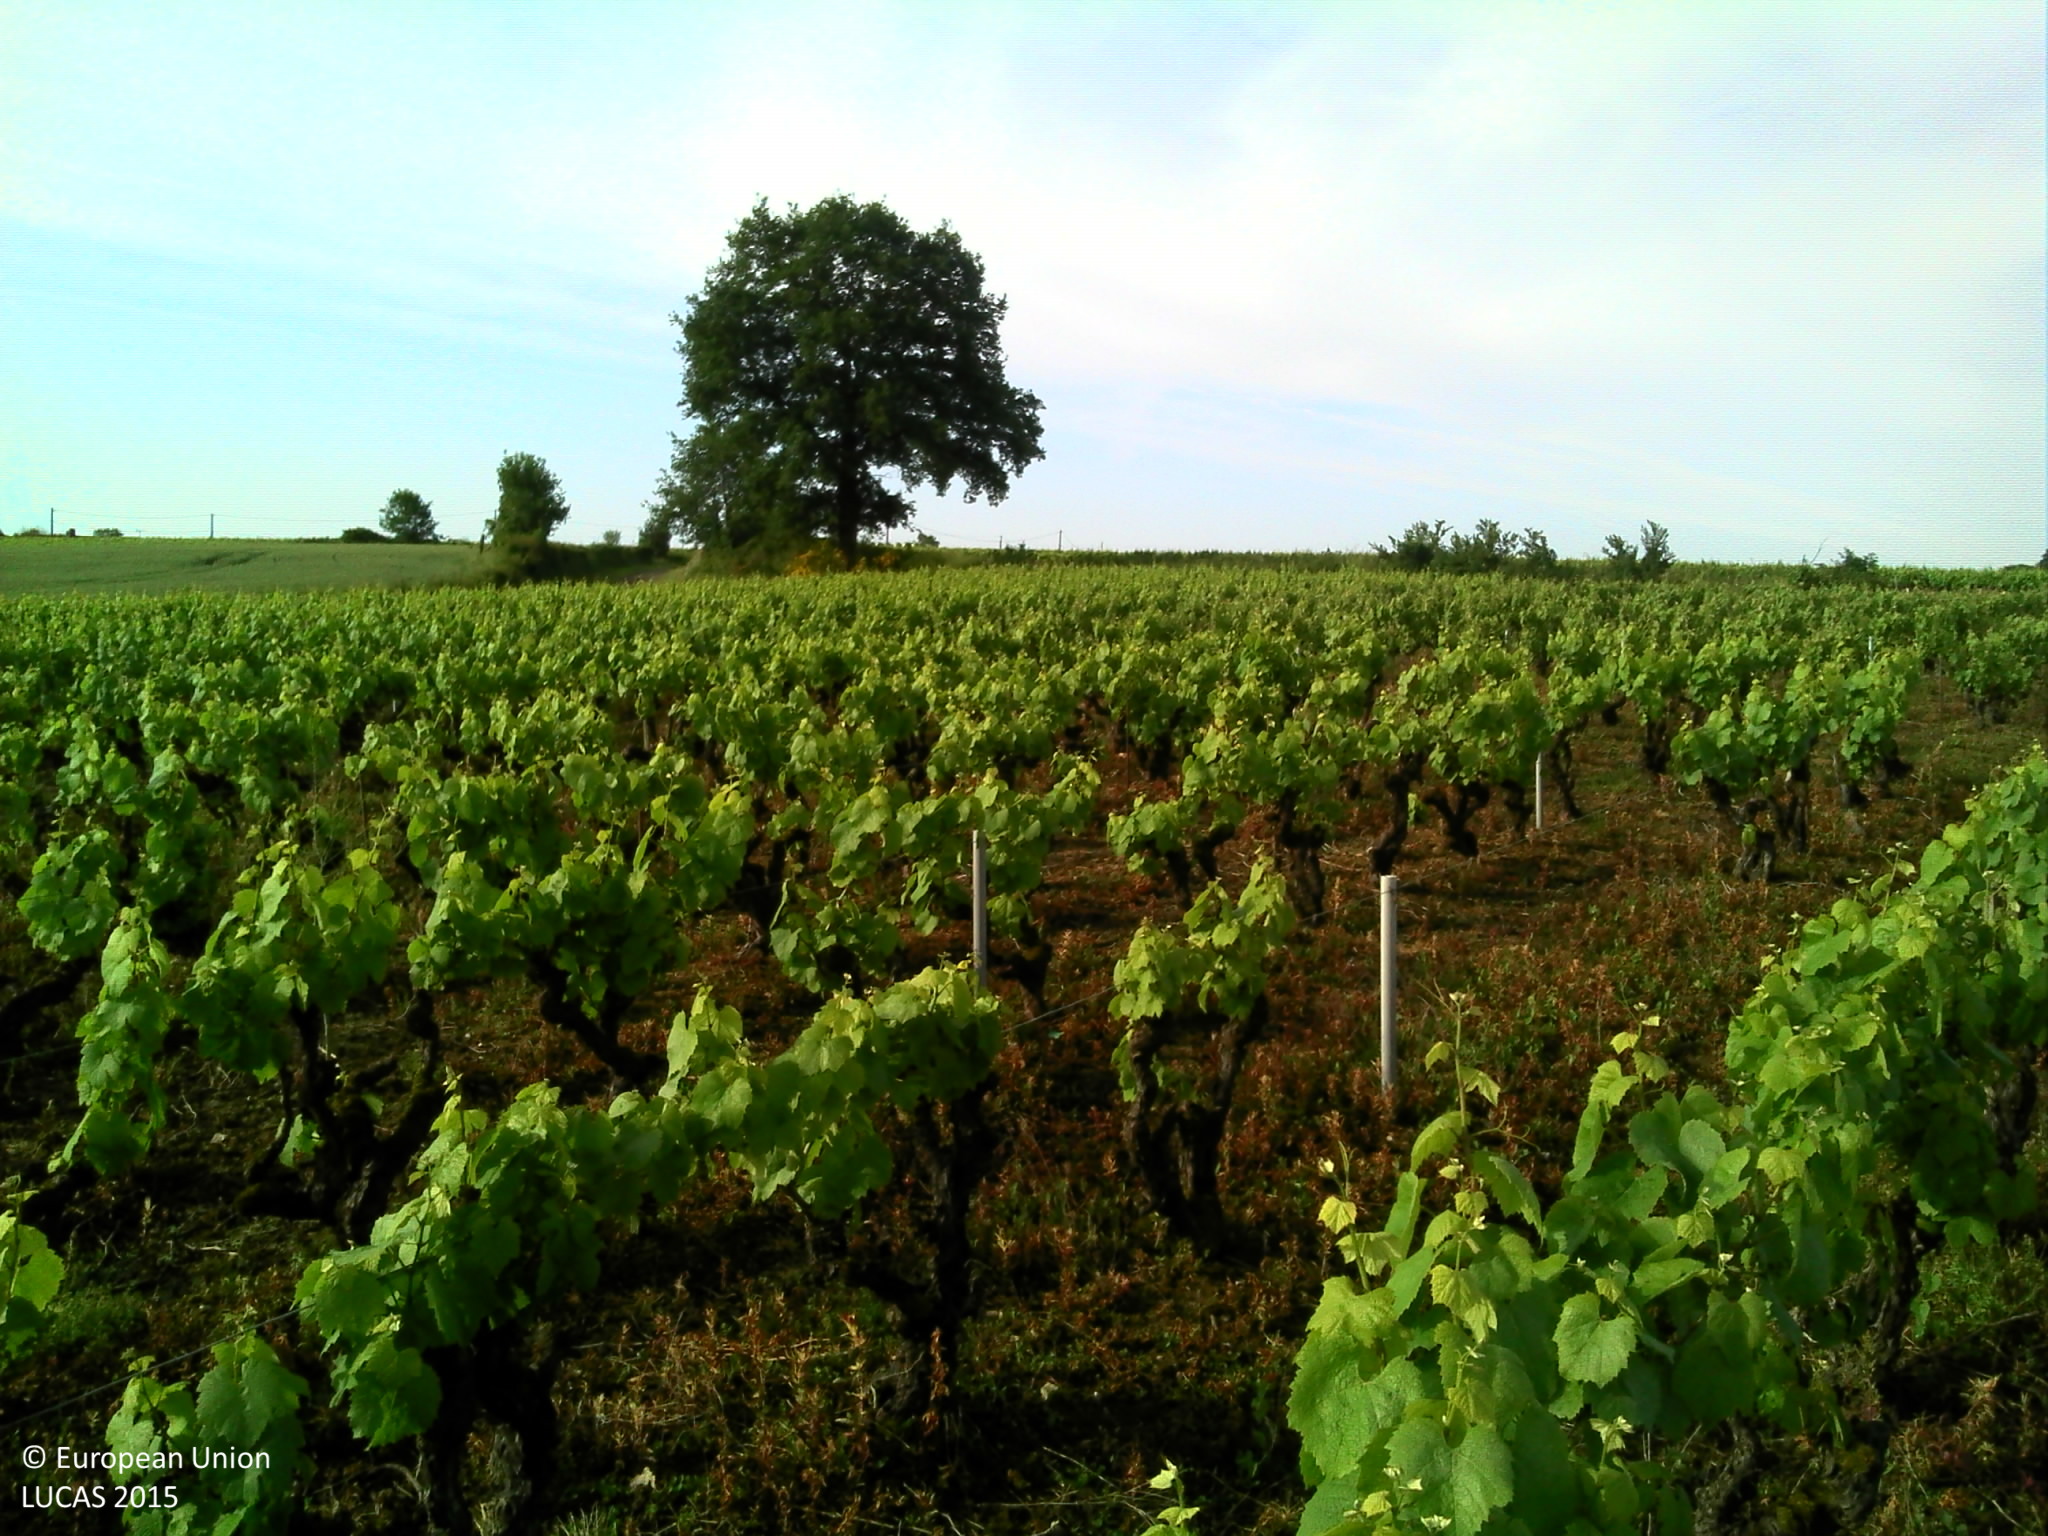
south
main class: Cropland
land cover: Vineyards
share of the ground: > 75 %
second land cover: Spontaneously vegetated surfaces
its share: 25 - 50 %
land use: Agriculture (excluding fallow land and kitchen gardens)
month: June
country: FR
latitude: 47.2960
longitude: -1.2930
